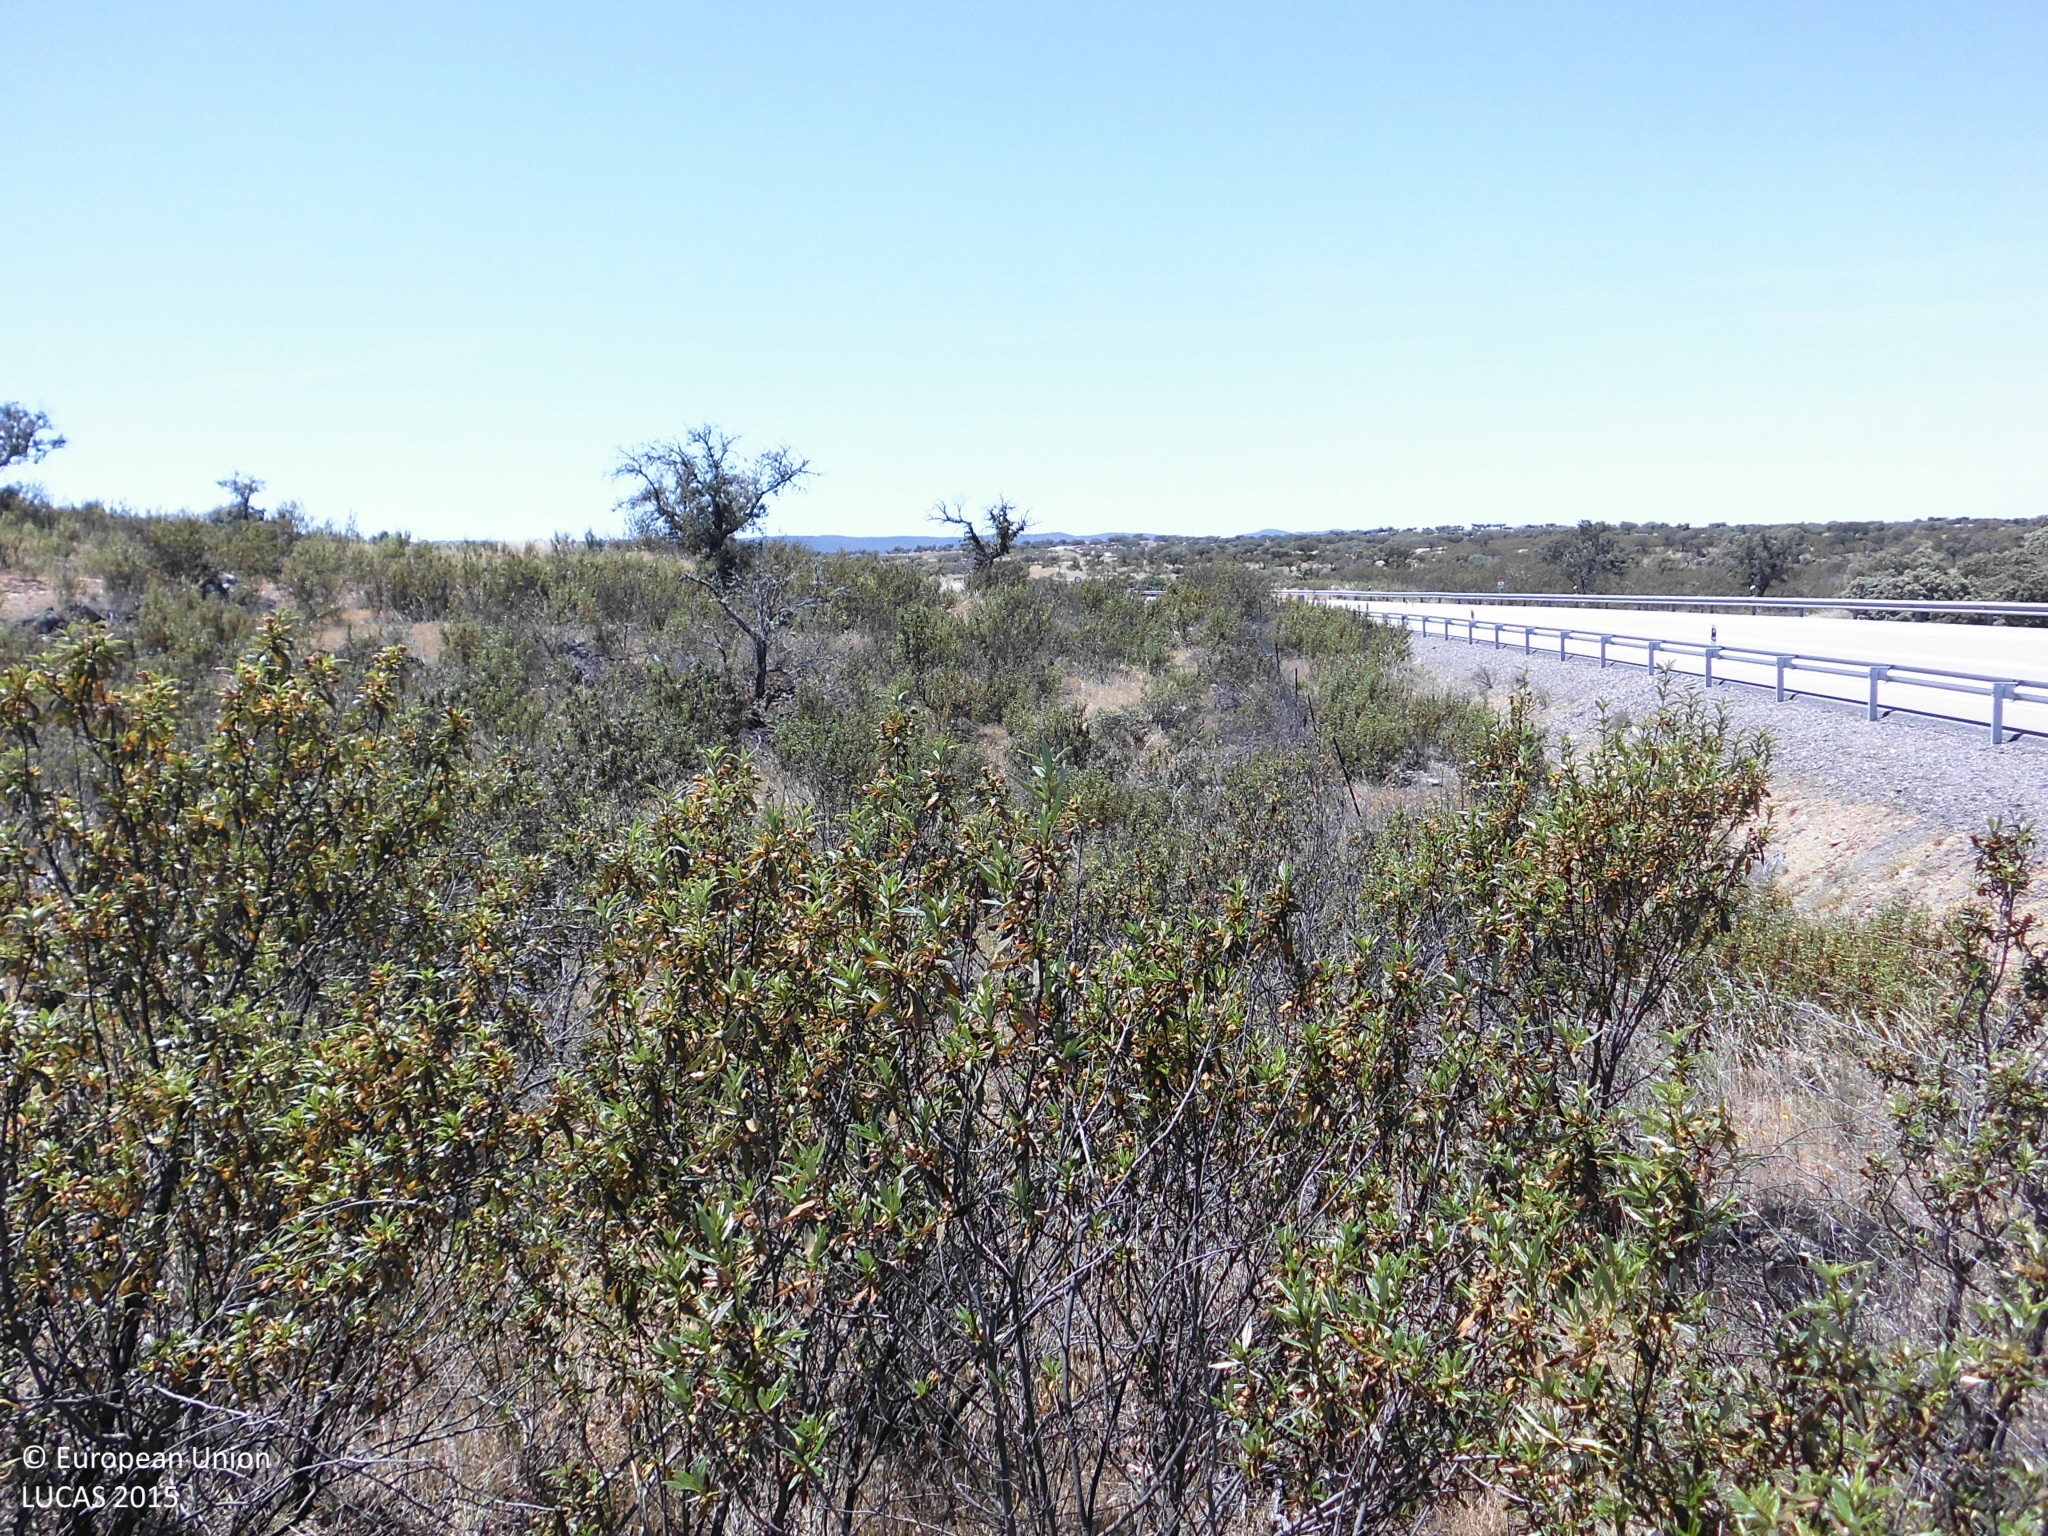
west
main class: Shrubland
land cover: Shrubland without tree cover
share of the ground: > 75 %
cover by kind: consolidated bare surface 40 %, shrubs 30 %, herbaceous plants 30 %
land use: Agriculture (excluding fallow land and kitchen gardens)
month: May
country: ES
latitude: 39.4635
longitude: -6.9447
